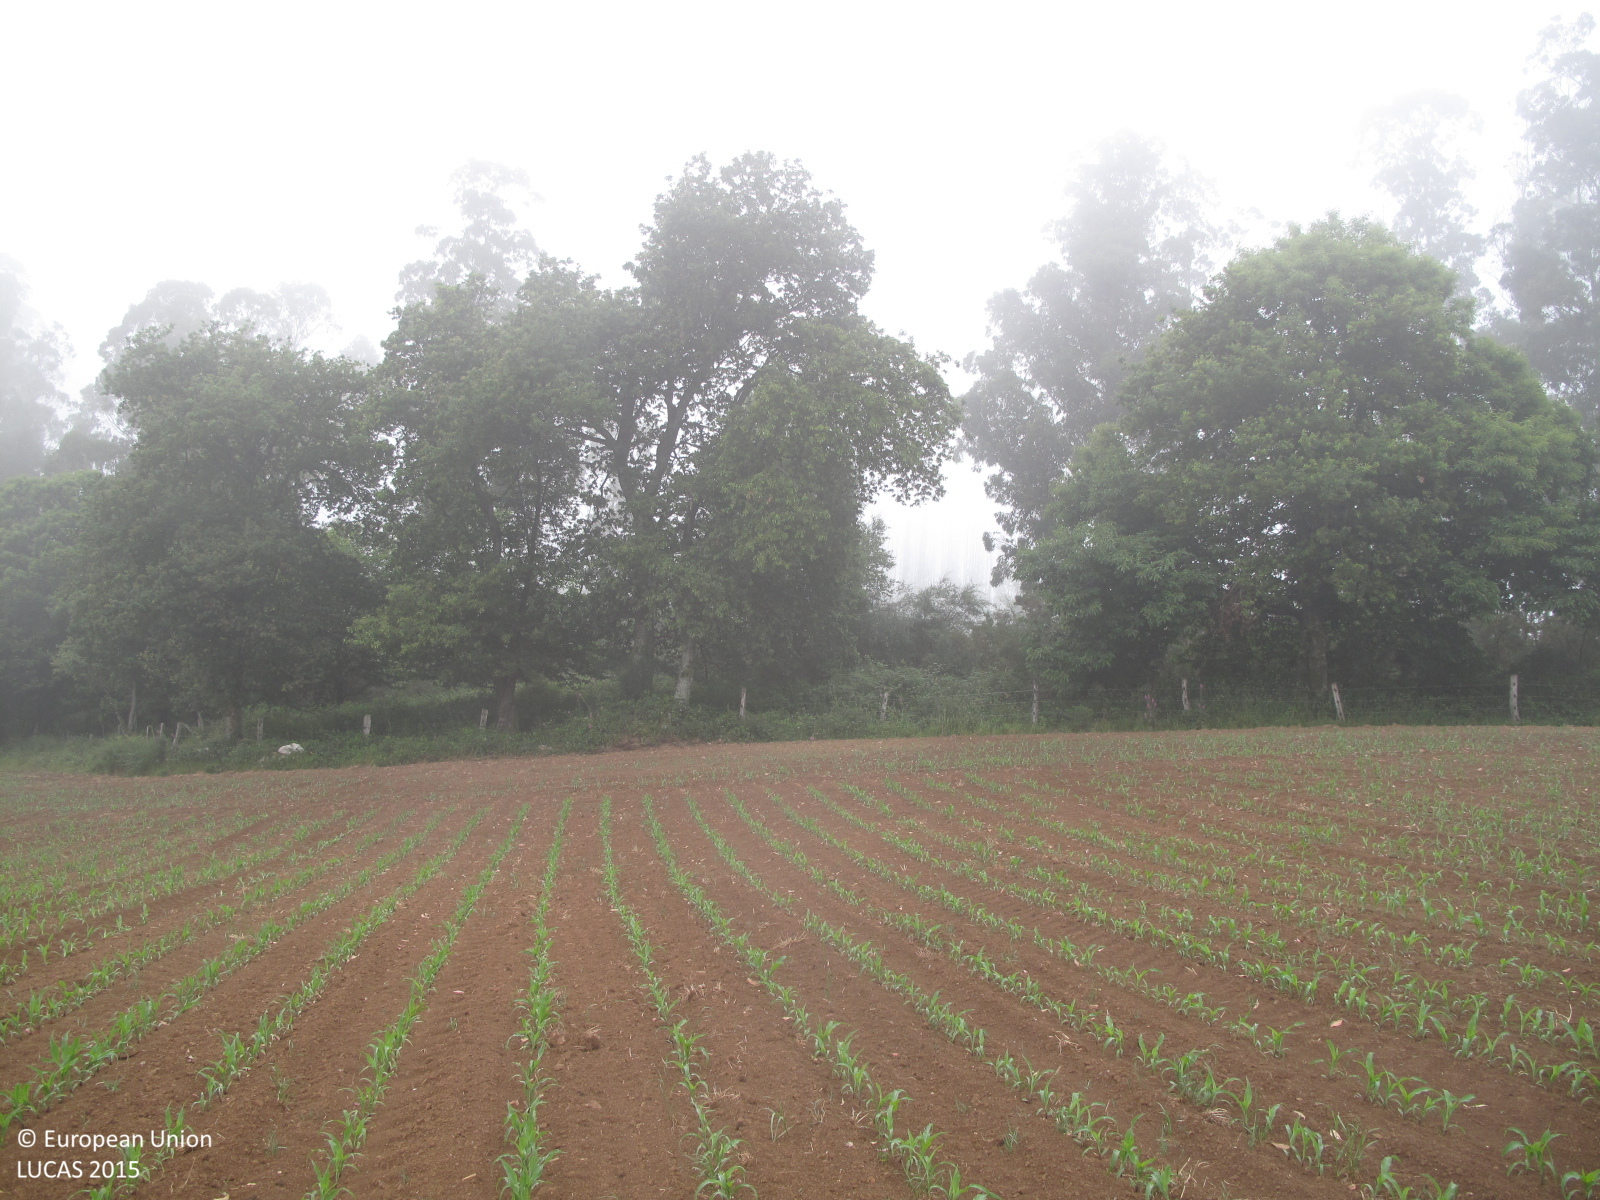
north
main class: Cropland
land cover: Maize
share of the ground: < 10 %
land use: Agriculture (excluding fallow land and kitchen gardens)
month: June
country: ES
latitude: 43.1294
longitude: -8.2046
